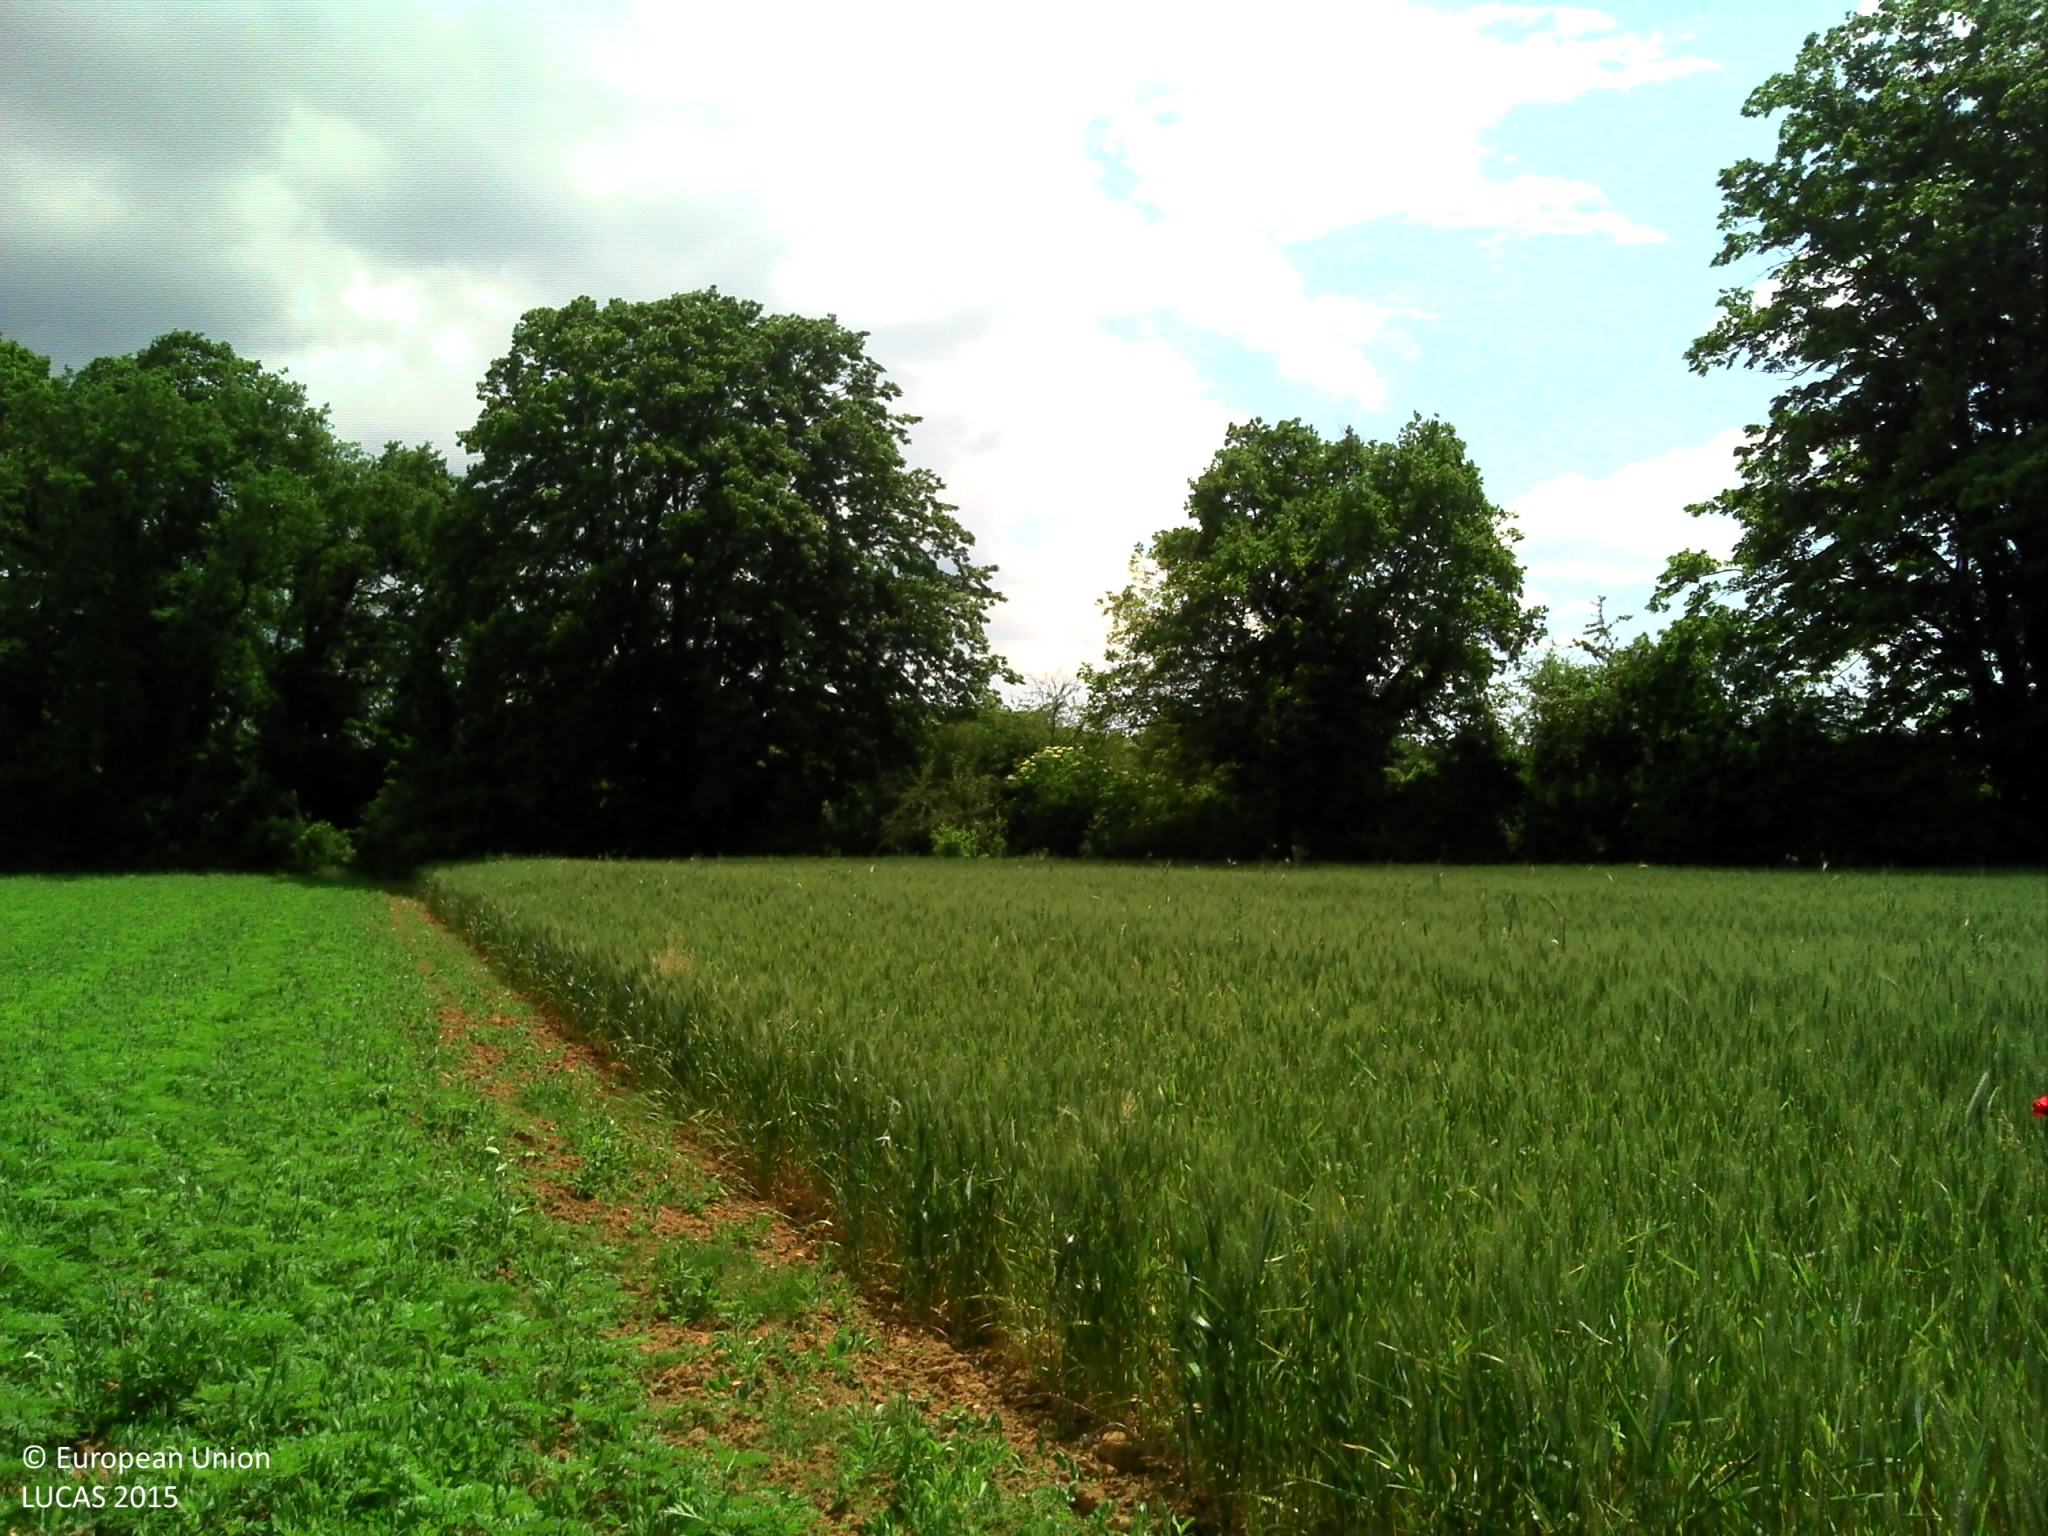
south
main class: Cropland
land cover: Other leguminous and mixtures for fodder
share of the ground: > 75 %
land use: Agriculture (excluding fallow land and kitchen gardens)
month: May
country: FR
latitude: 44.9933
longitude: 5.0968
